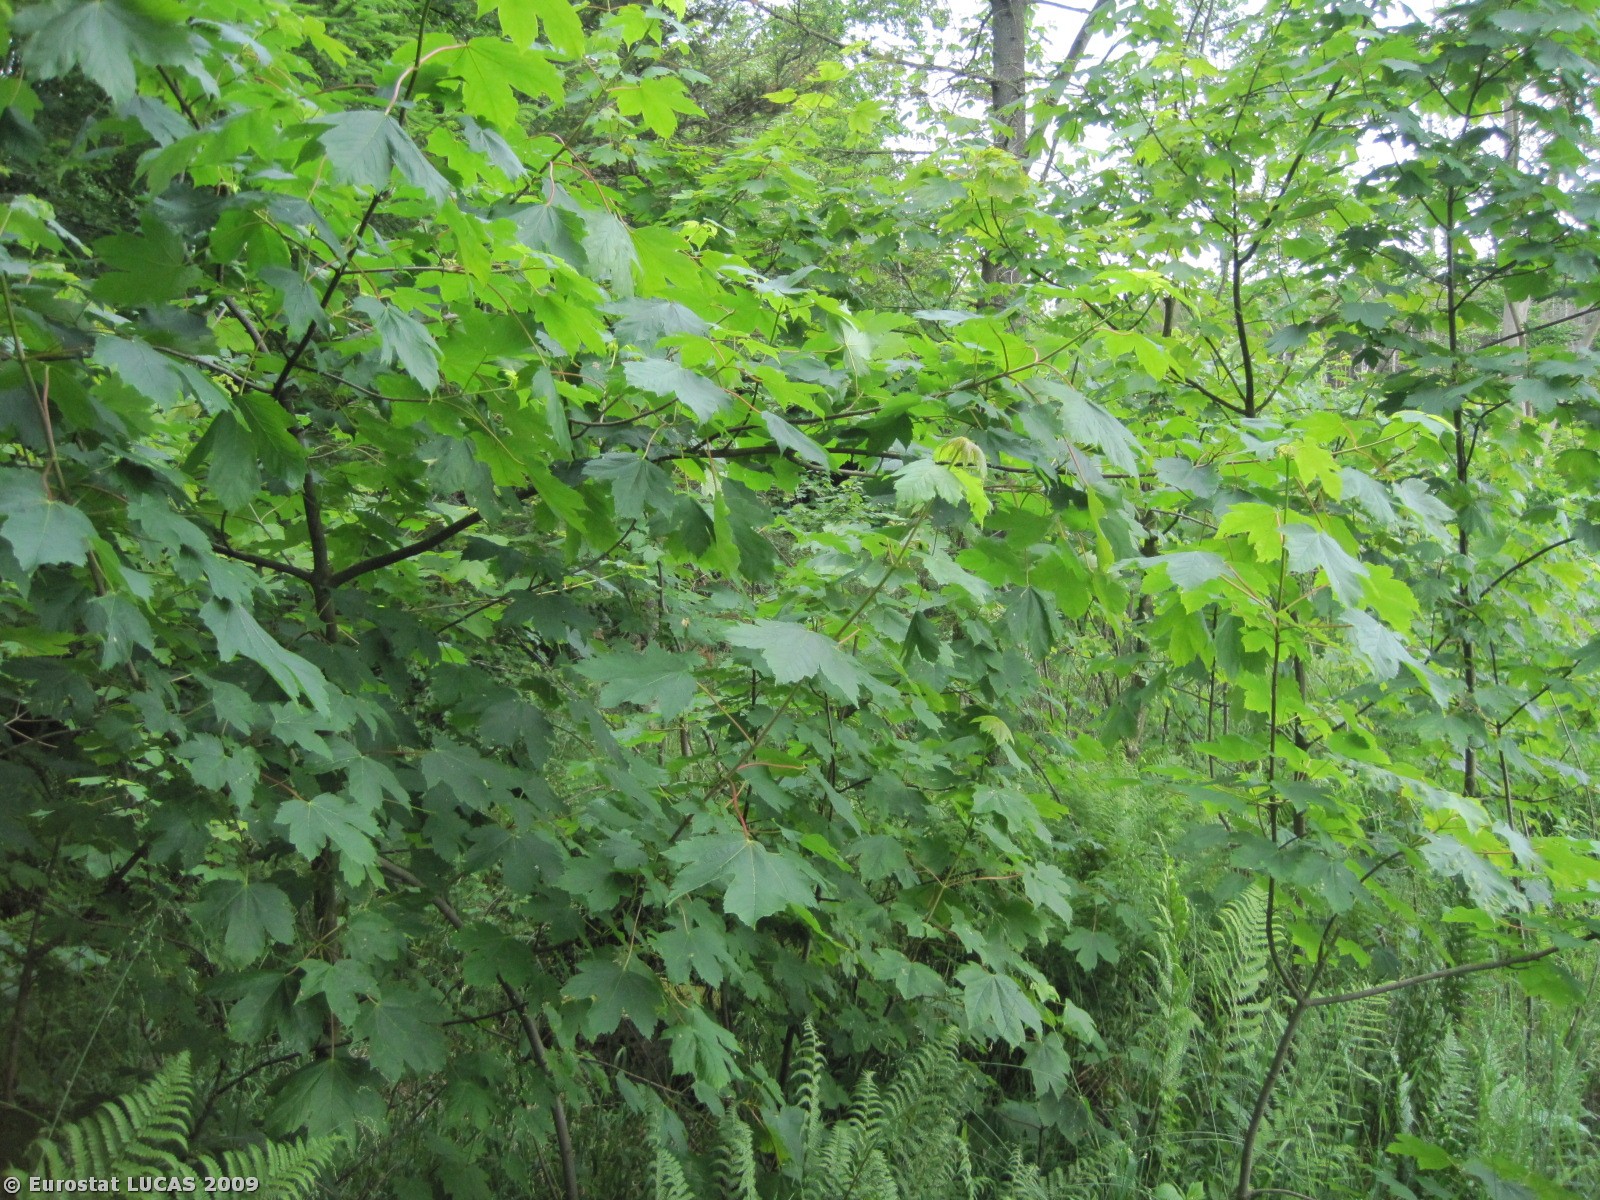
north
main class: Woodland
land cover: Mixed woodland
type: plantations and self-sown exotic forest
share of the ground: 50 - 75 %
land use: Agriculture (excluding fallow land and kitchen gardens)
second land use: Amenities, museums, leisure
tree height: > 5 m
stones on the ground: < 10 %
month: June
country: DK
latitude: 57.0865
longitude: 10.1483
